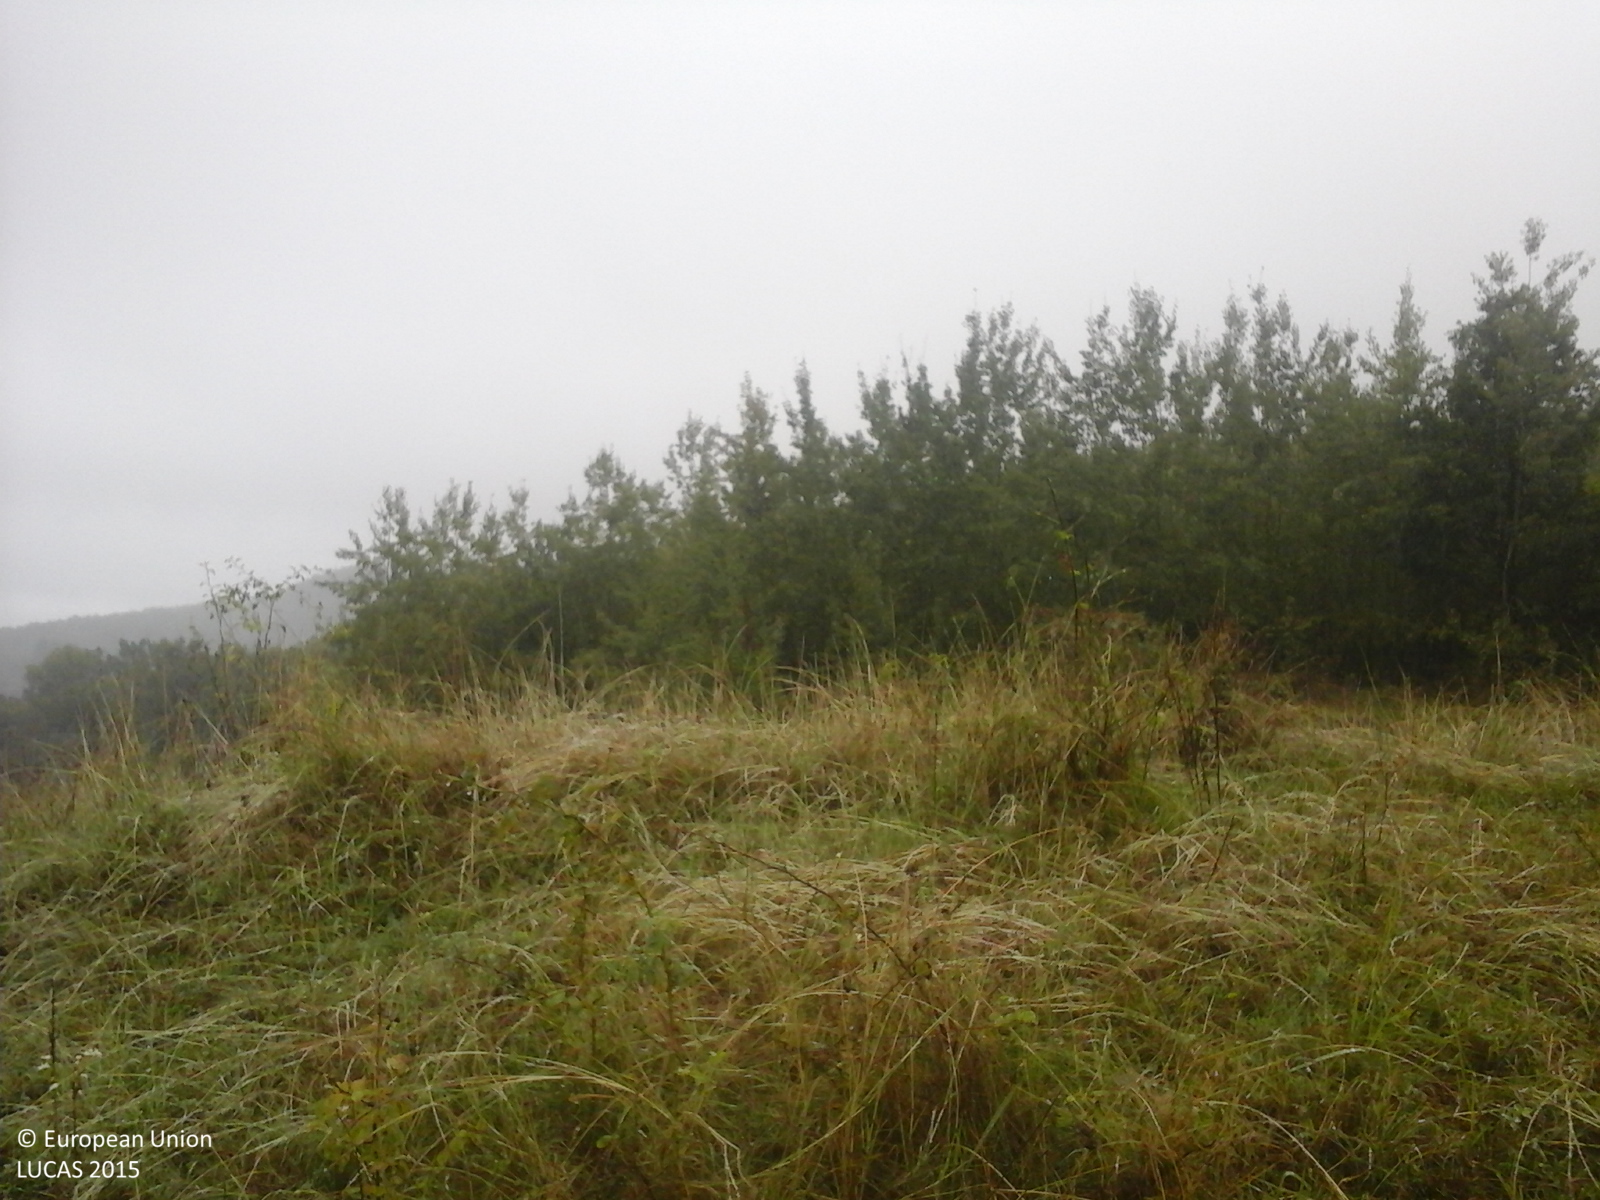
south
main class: Grassland
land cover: Grassland with sparse tree/shrub cover
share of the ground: > 75 %
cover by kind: herbaceous plants 85 %, shrubs 10 %, broadleaved forest trees 5 %
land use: Agriculture (excluding fallow land and kitchen gardens)
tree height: < 5 m
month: September
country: RO
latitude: 44.9937
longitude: 23.6706
